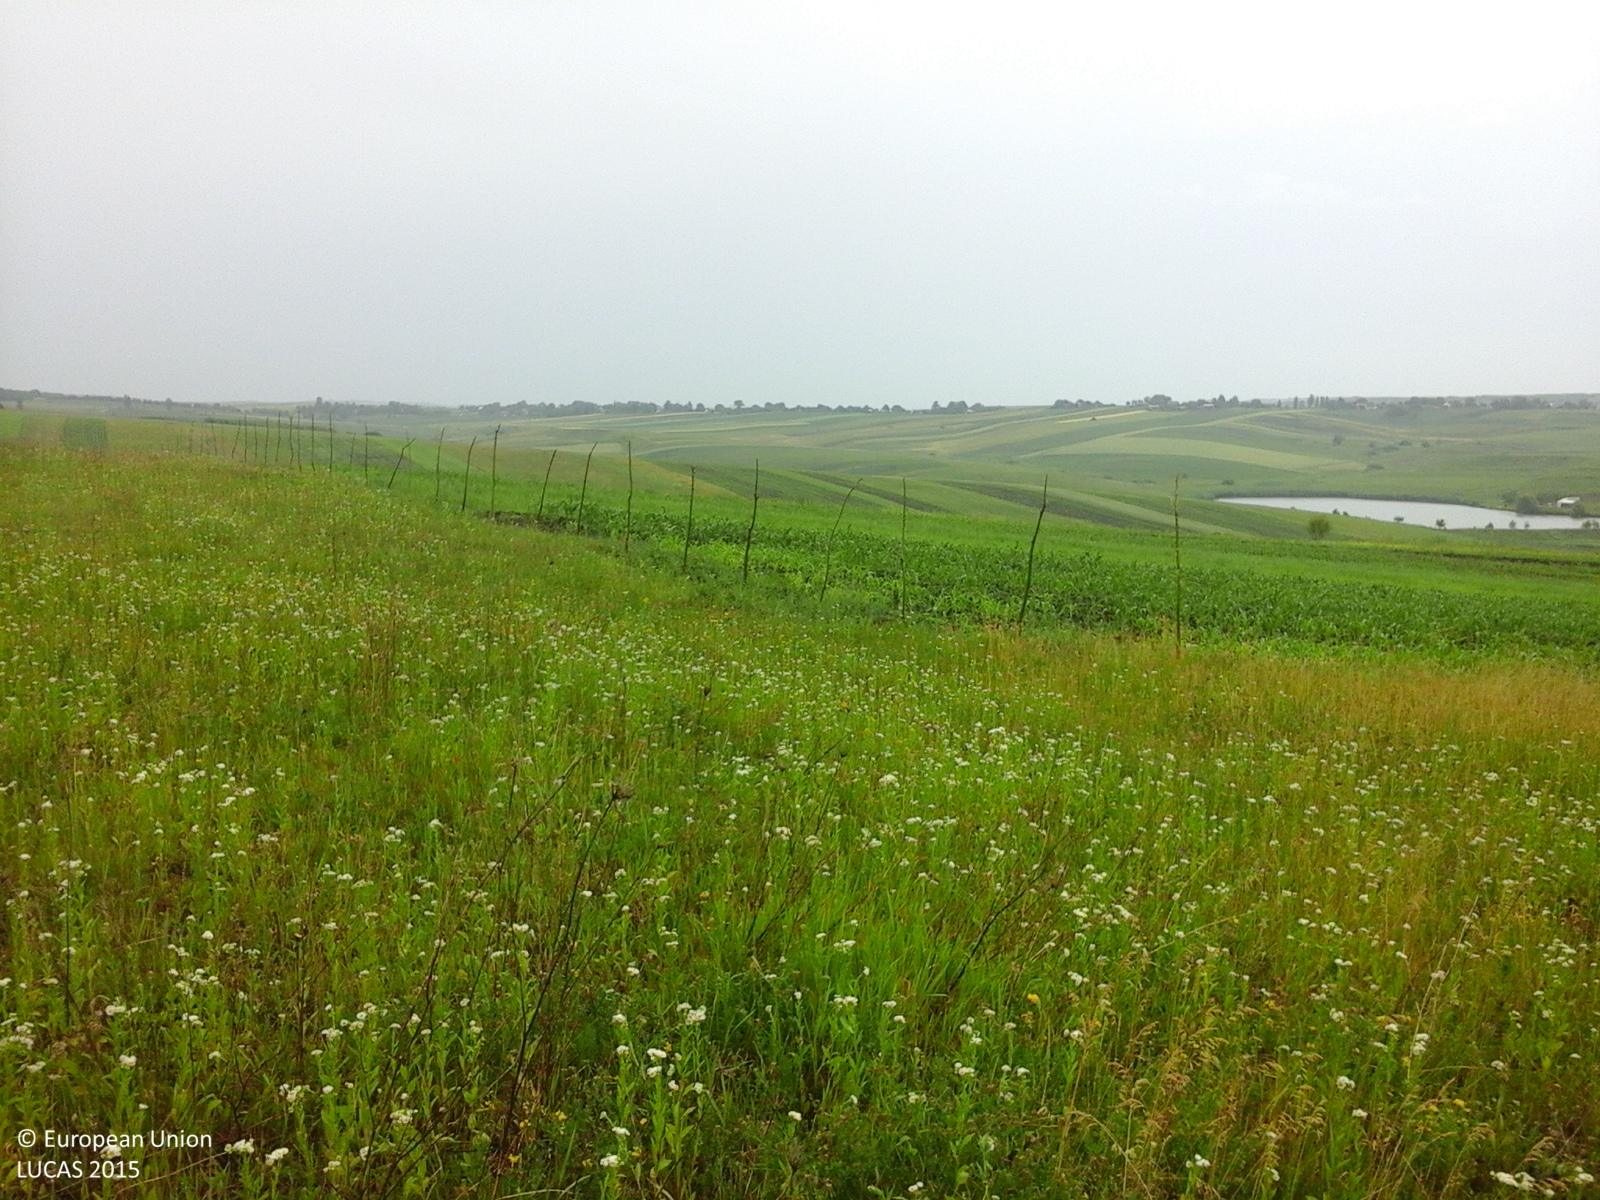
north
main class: Grassland
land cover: Grassland without tree/shrub cover
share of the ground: > 75 %
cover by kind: herbaceous plants 100 %
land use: Agriculture (excluding fallow land and kitchen gardens)
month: June
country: RO
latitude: 47.3598
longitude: 26.4650
